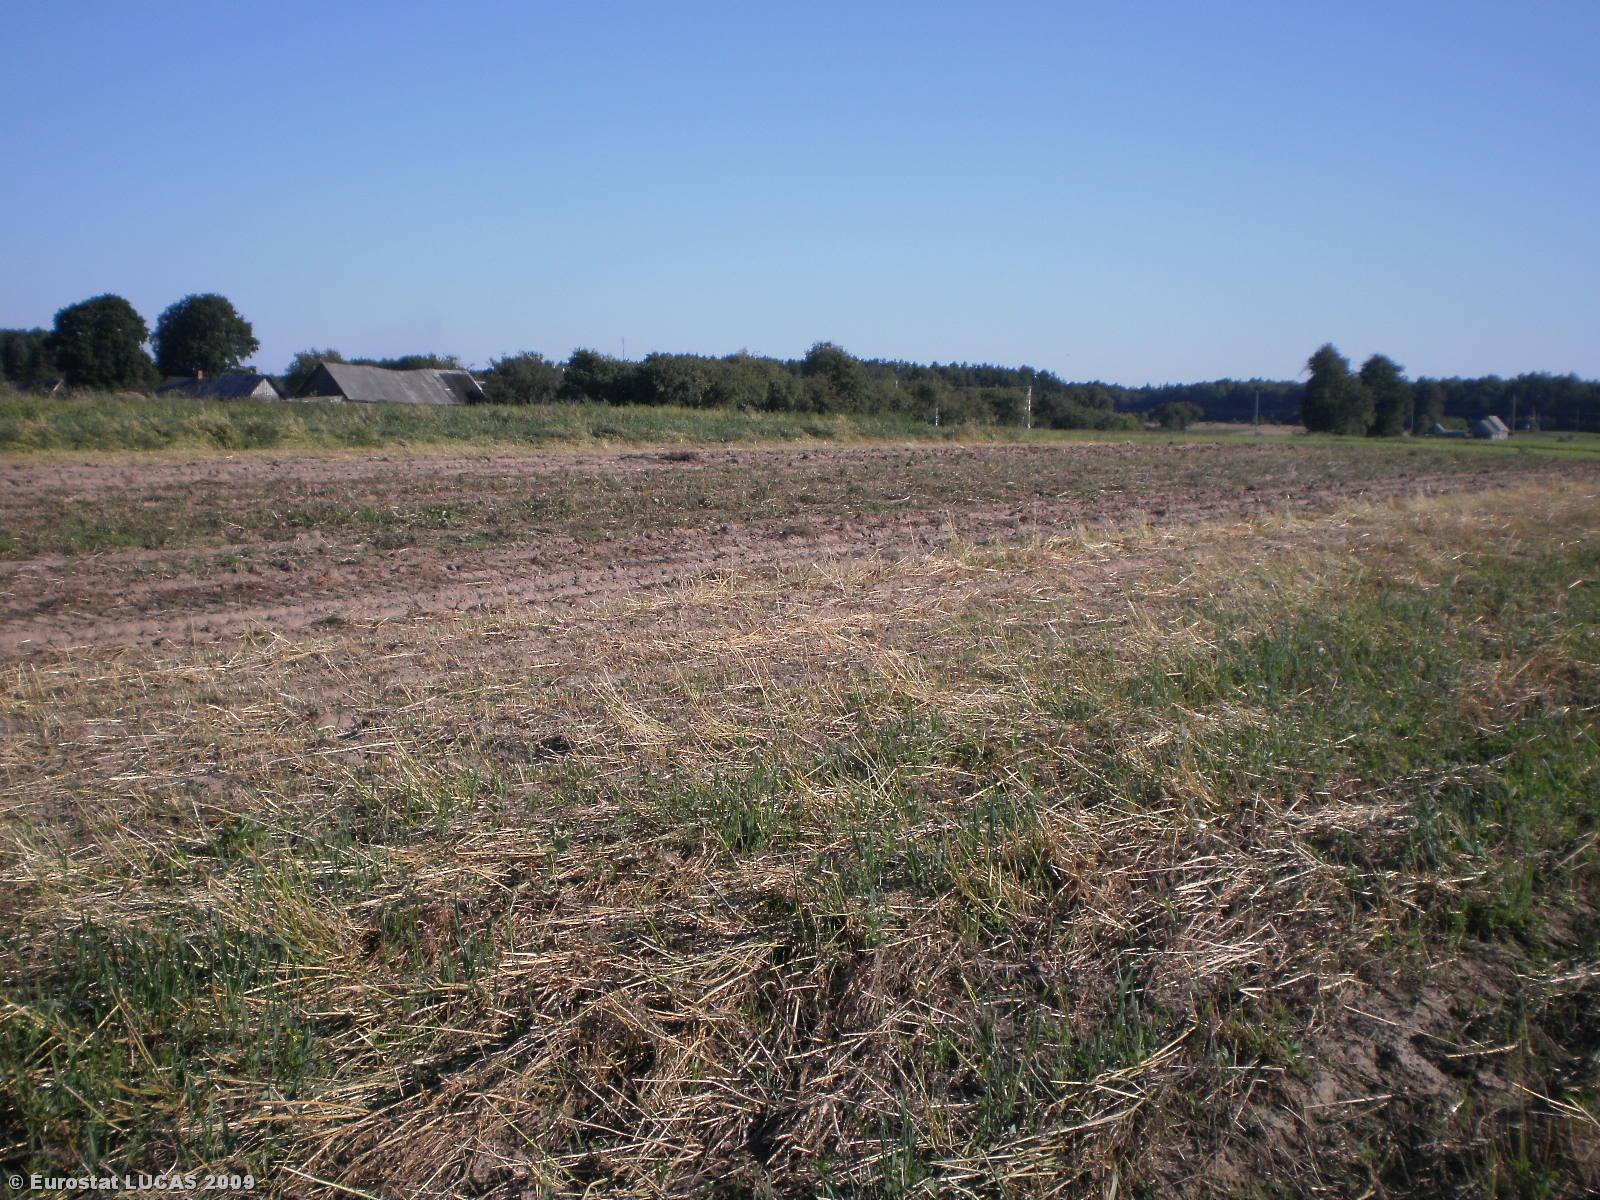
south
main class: Grassland
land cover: Spontaneously vegetated surfaces
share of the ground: > 75 %
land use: Fallow land
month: August
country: LT
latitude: 54.8369
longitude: 24.7275
